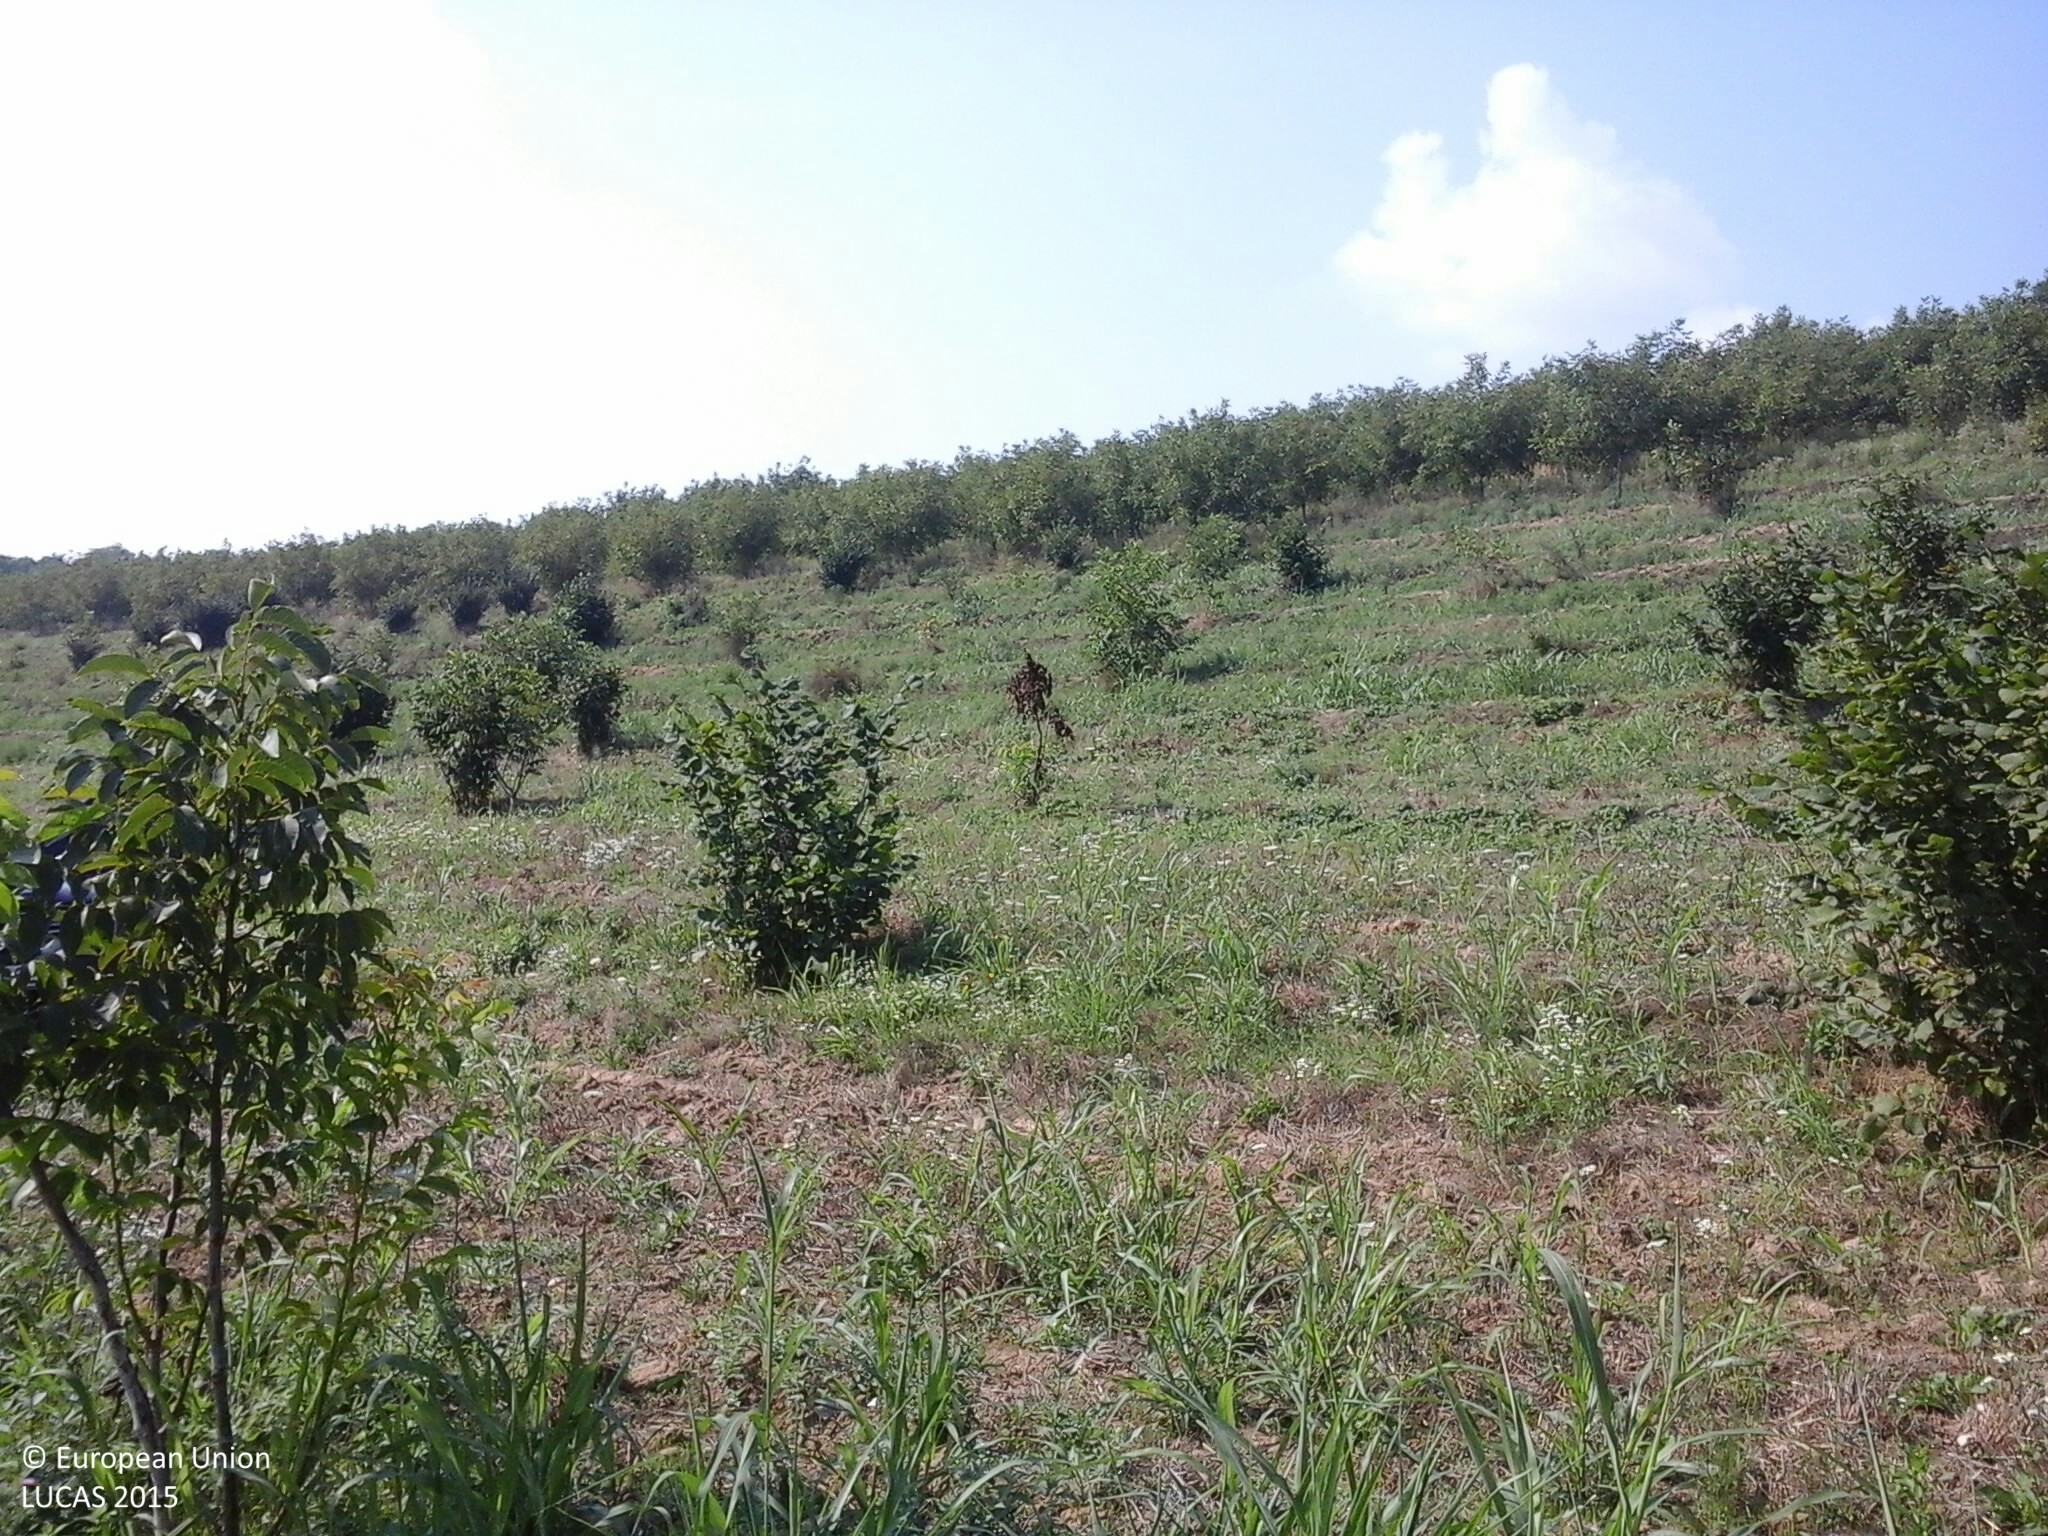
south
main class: Cropland
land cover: Maize
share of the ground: > 75 %
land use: Agriculture (excluding fallow land and kitchen gardens)
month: August
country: HU
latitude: 46.6171
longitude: 17.9338
